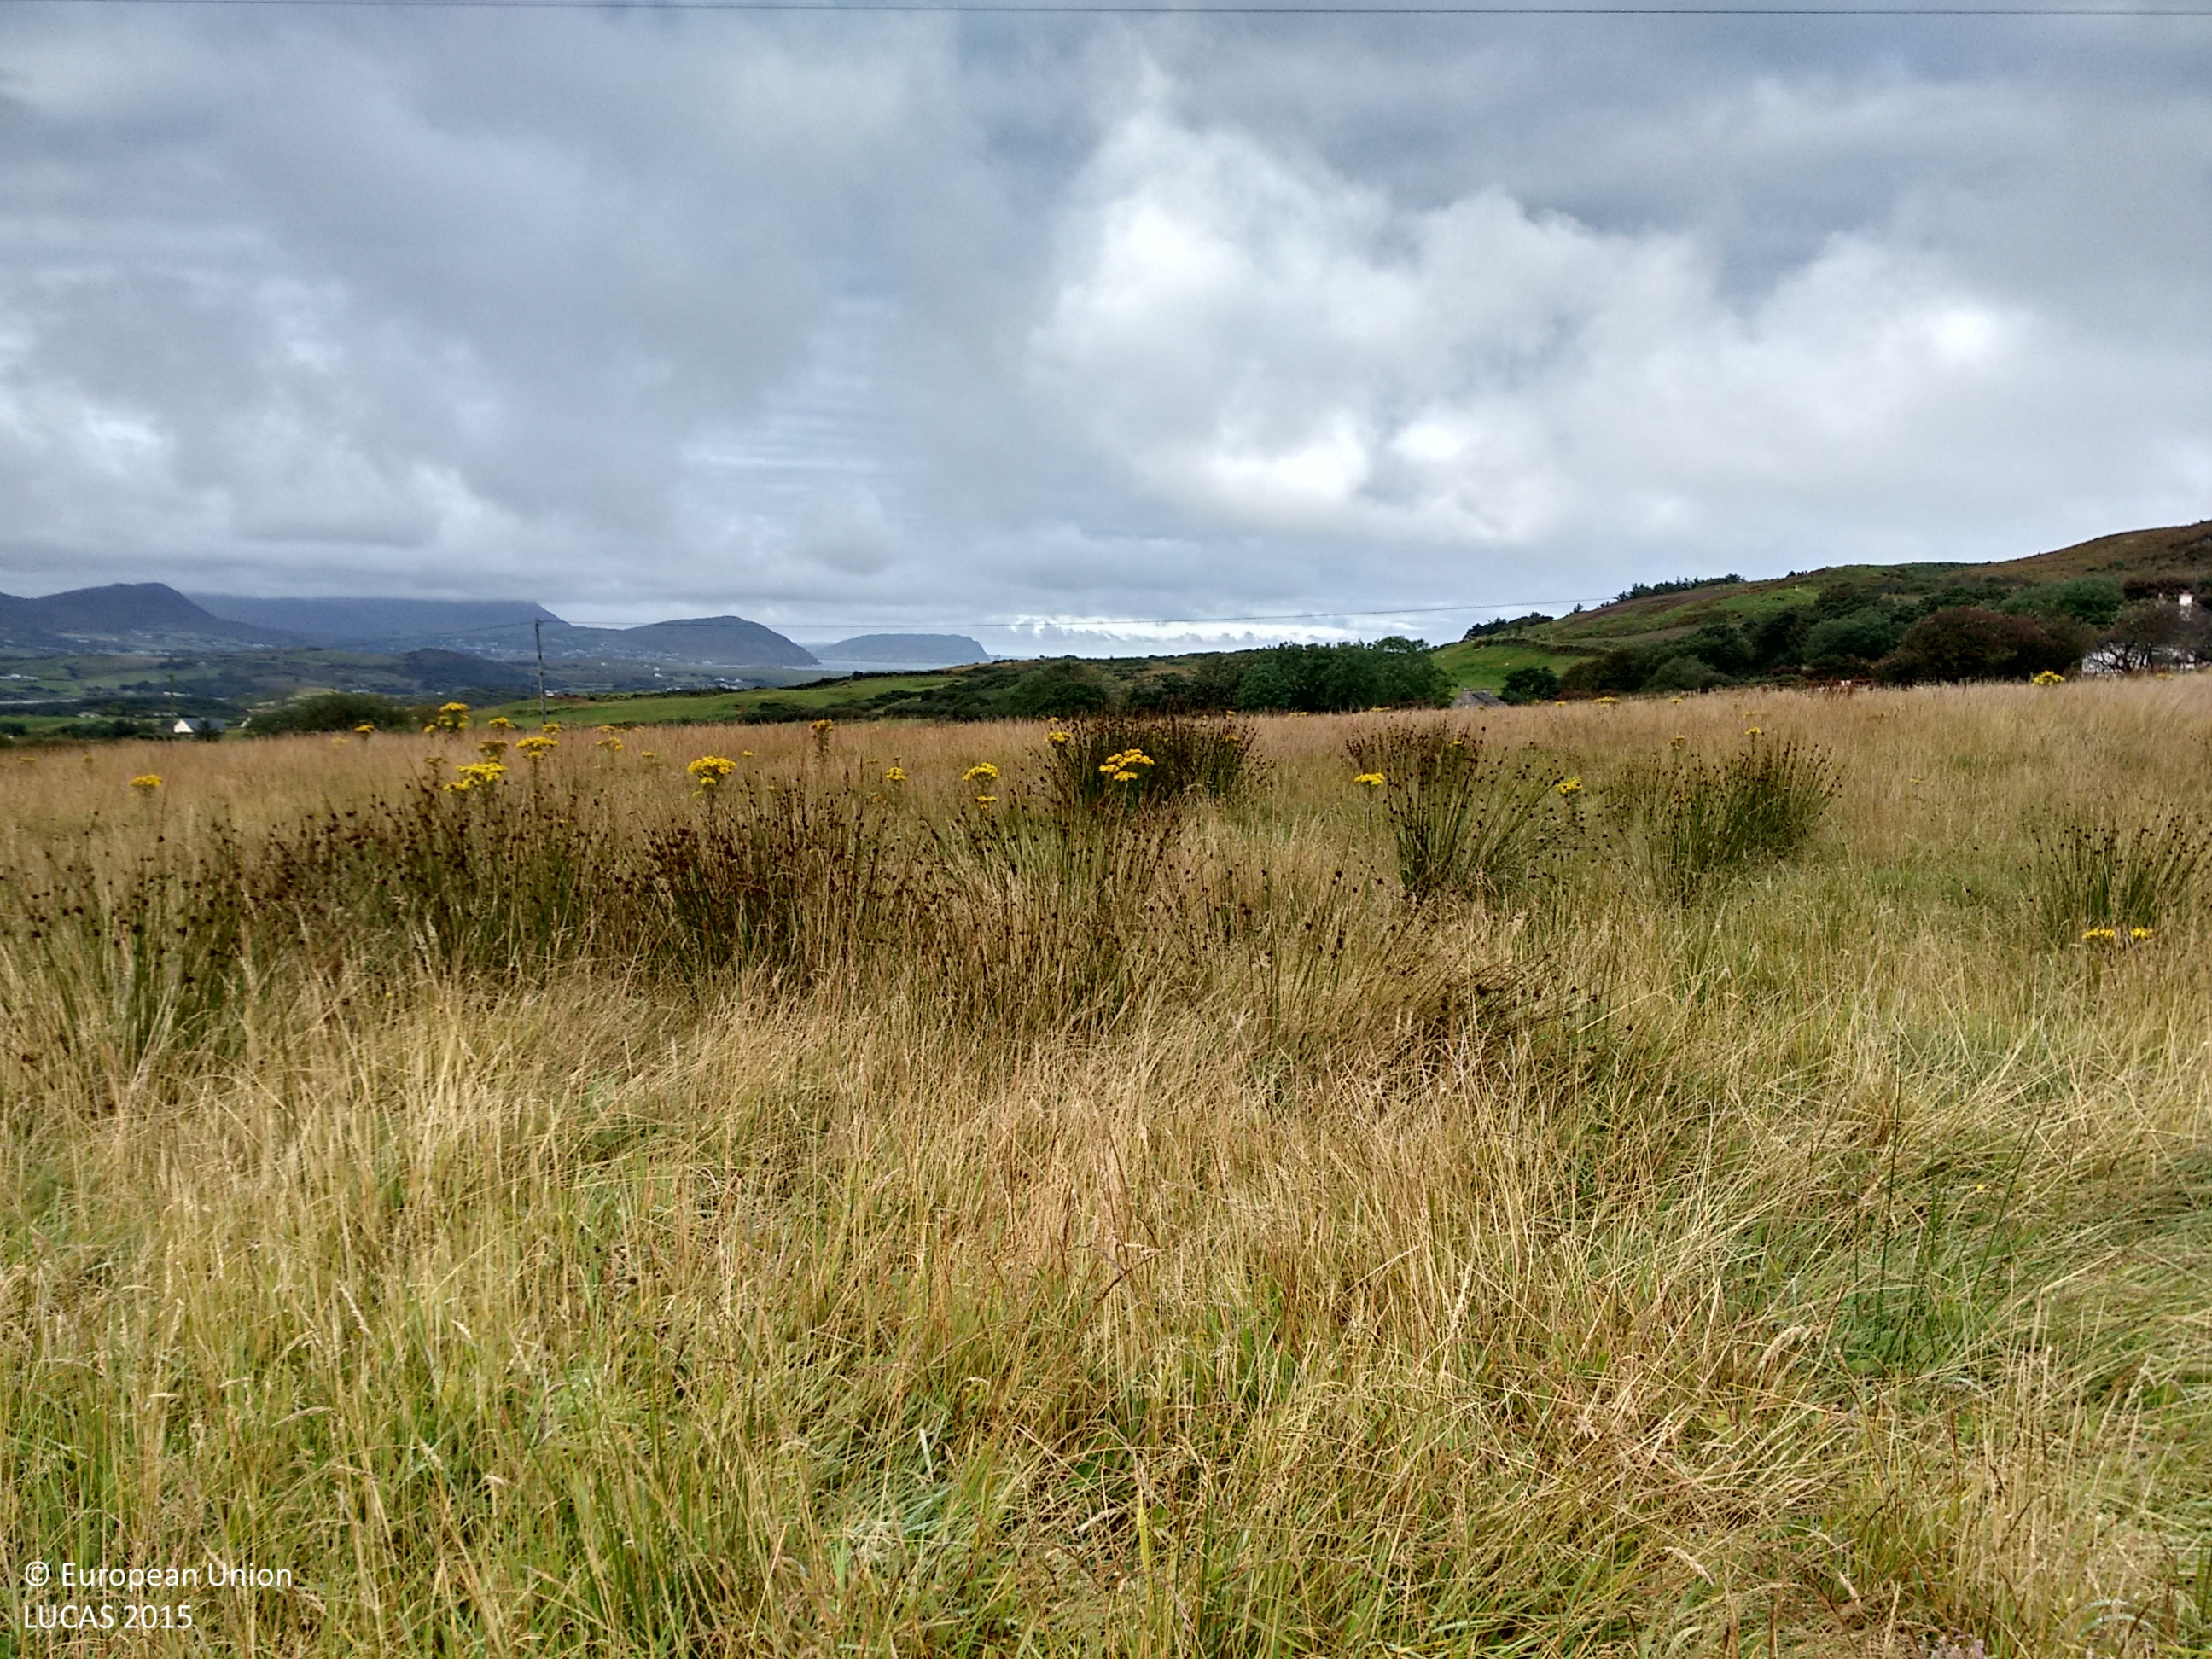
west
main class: Grassland
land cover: Grassland without tree/shrub cover
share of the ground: > 75 %
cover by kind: herbaceous plants 100 %
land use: Agriculture (excluding fallow land and kitchen gardens)
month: September
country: IE
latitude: 55.3159
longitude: -7.2734
